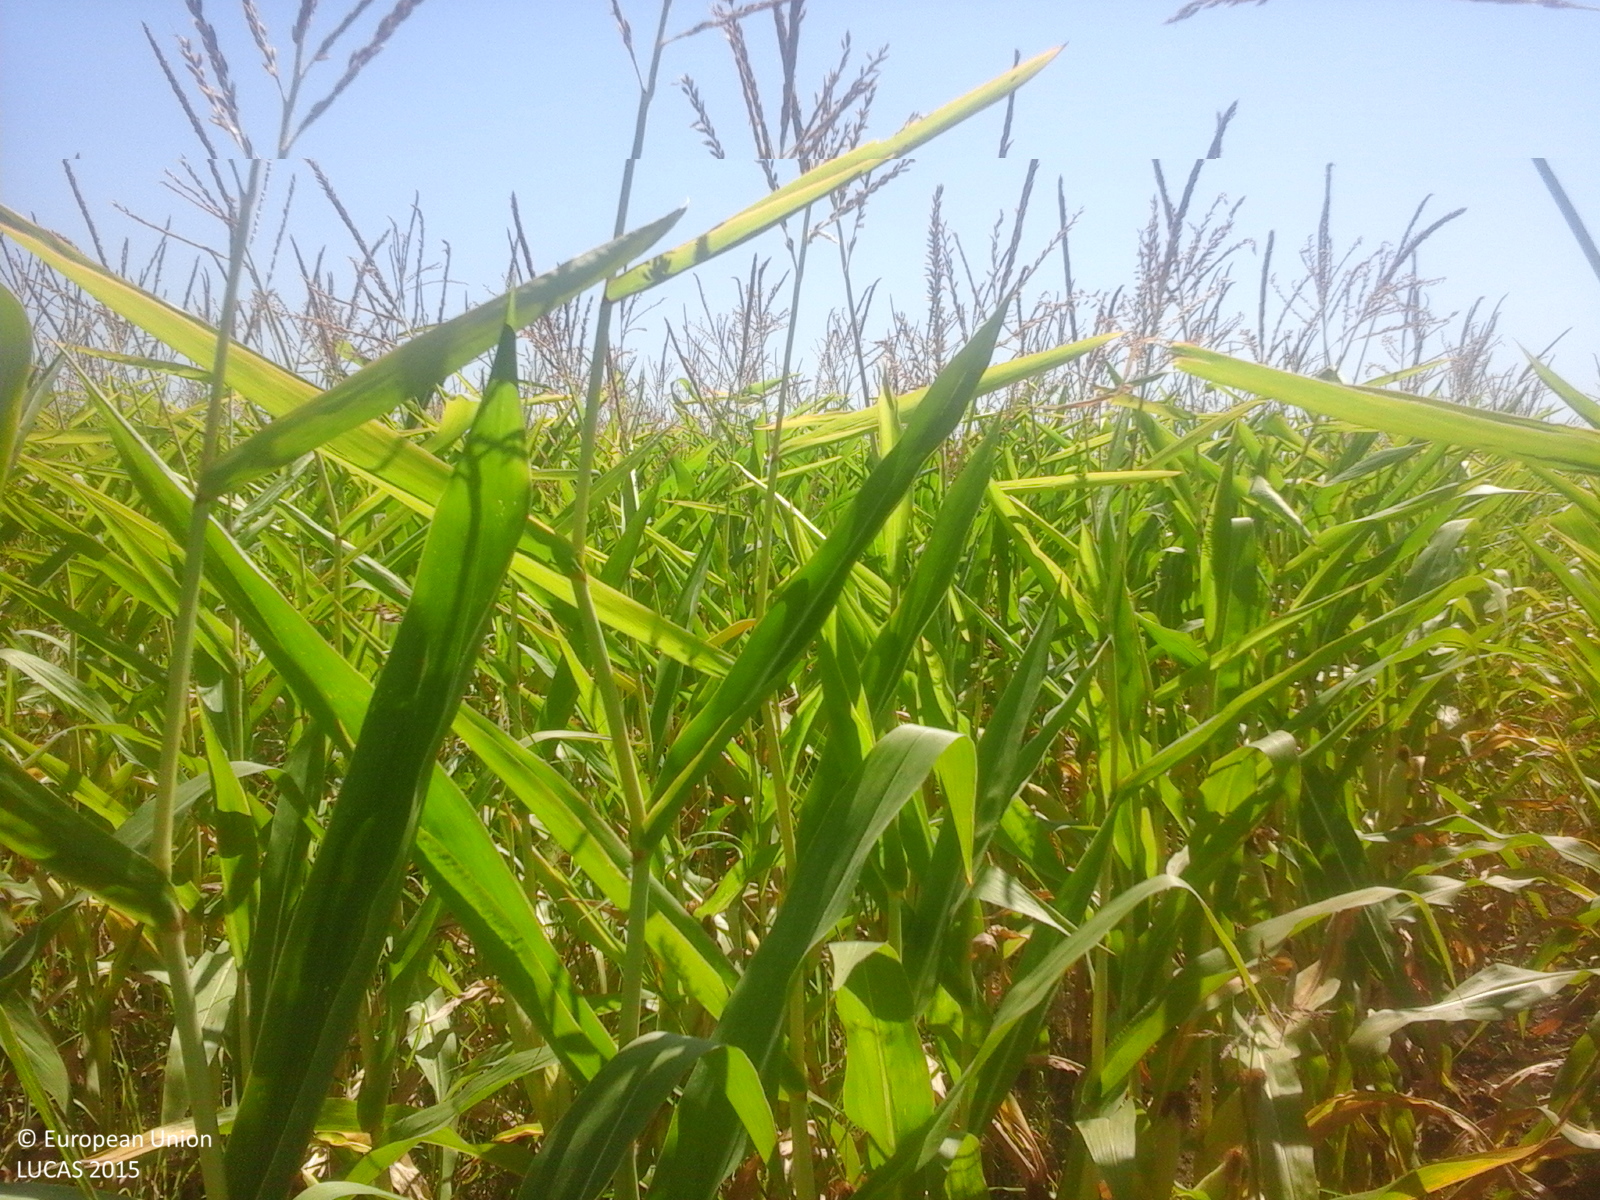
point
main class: Cropland
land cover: Maize
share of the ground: > 75 %
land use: Agriculture (excluding fallow land and kitchen gardens)
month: July
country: RO
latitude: 44.4124
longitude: 26.6322
